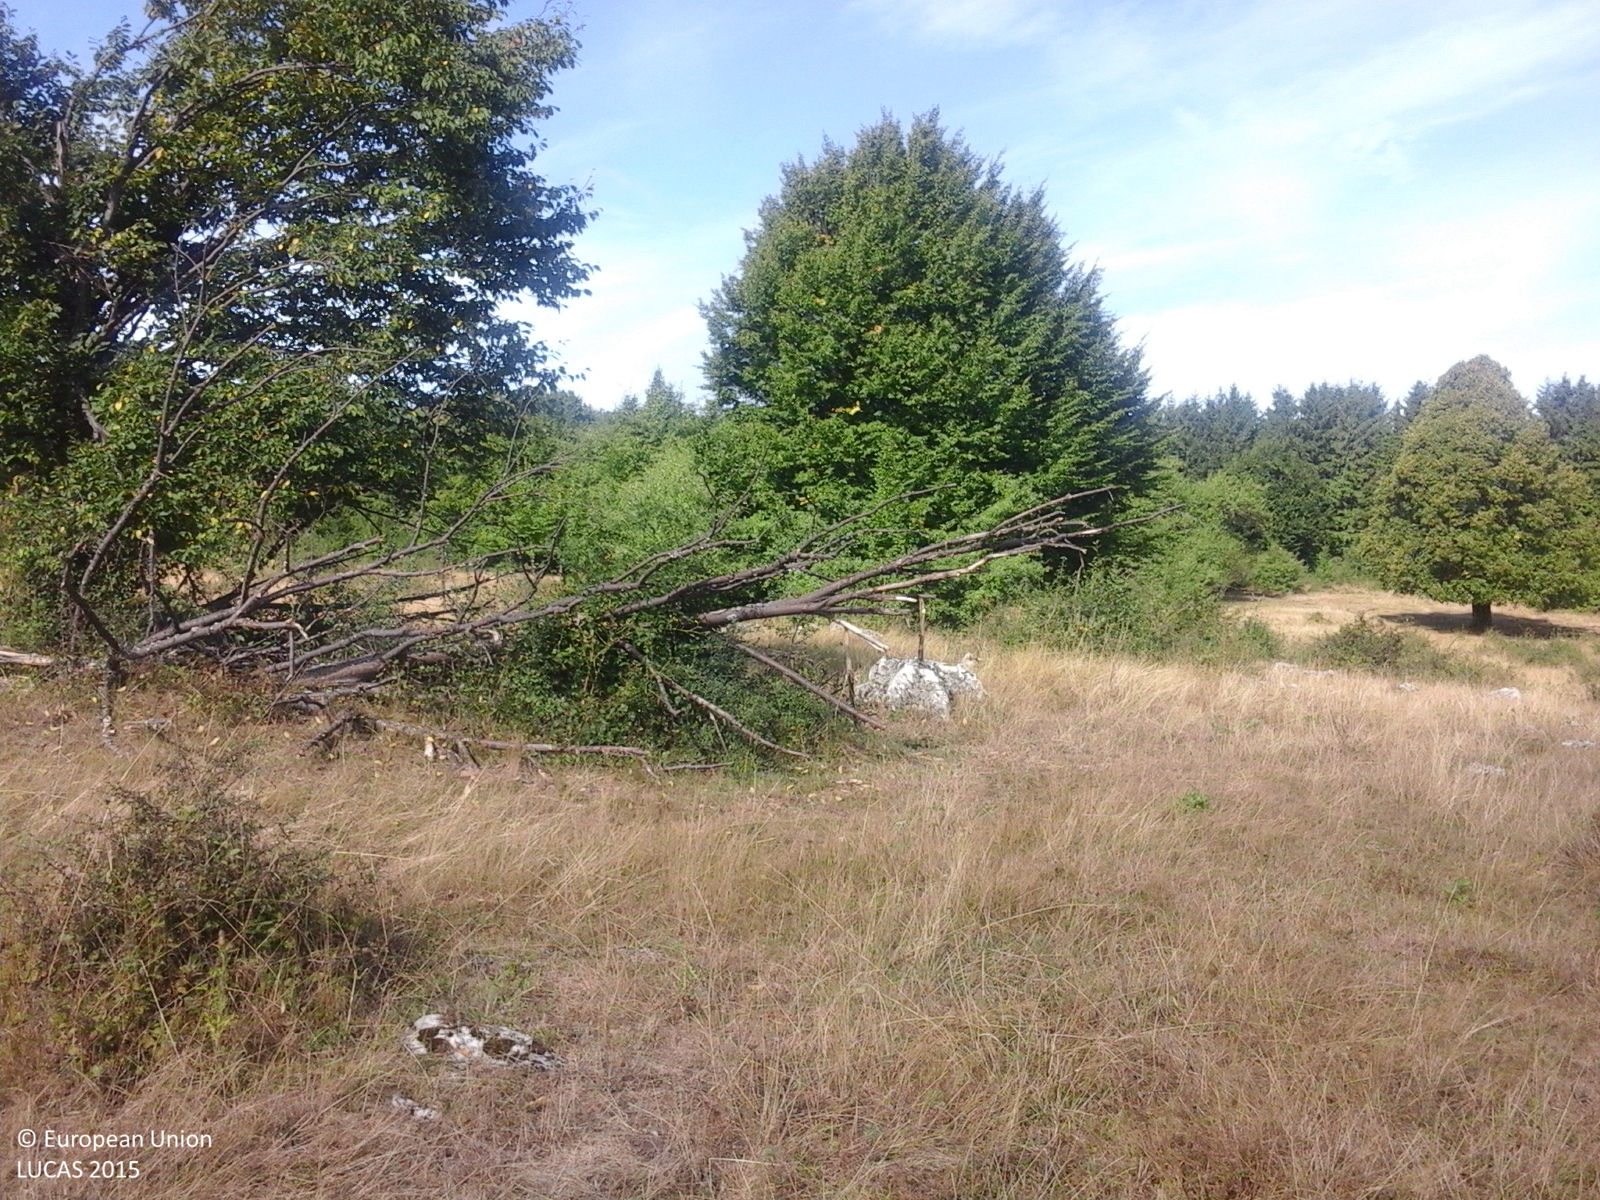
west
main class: Grassland
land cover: Grassland with sparse tree/shrub cover
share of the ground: > 75 %
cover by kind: herbaceous plants 85 %, shrubs 10 %, broadleaved forest trees 5 %
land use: Agriculture (excluding fallow land and kitchen gardens)
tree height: < 5 m
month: August
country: RO
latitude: 45.0936
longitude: 21.8125
